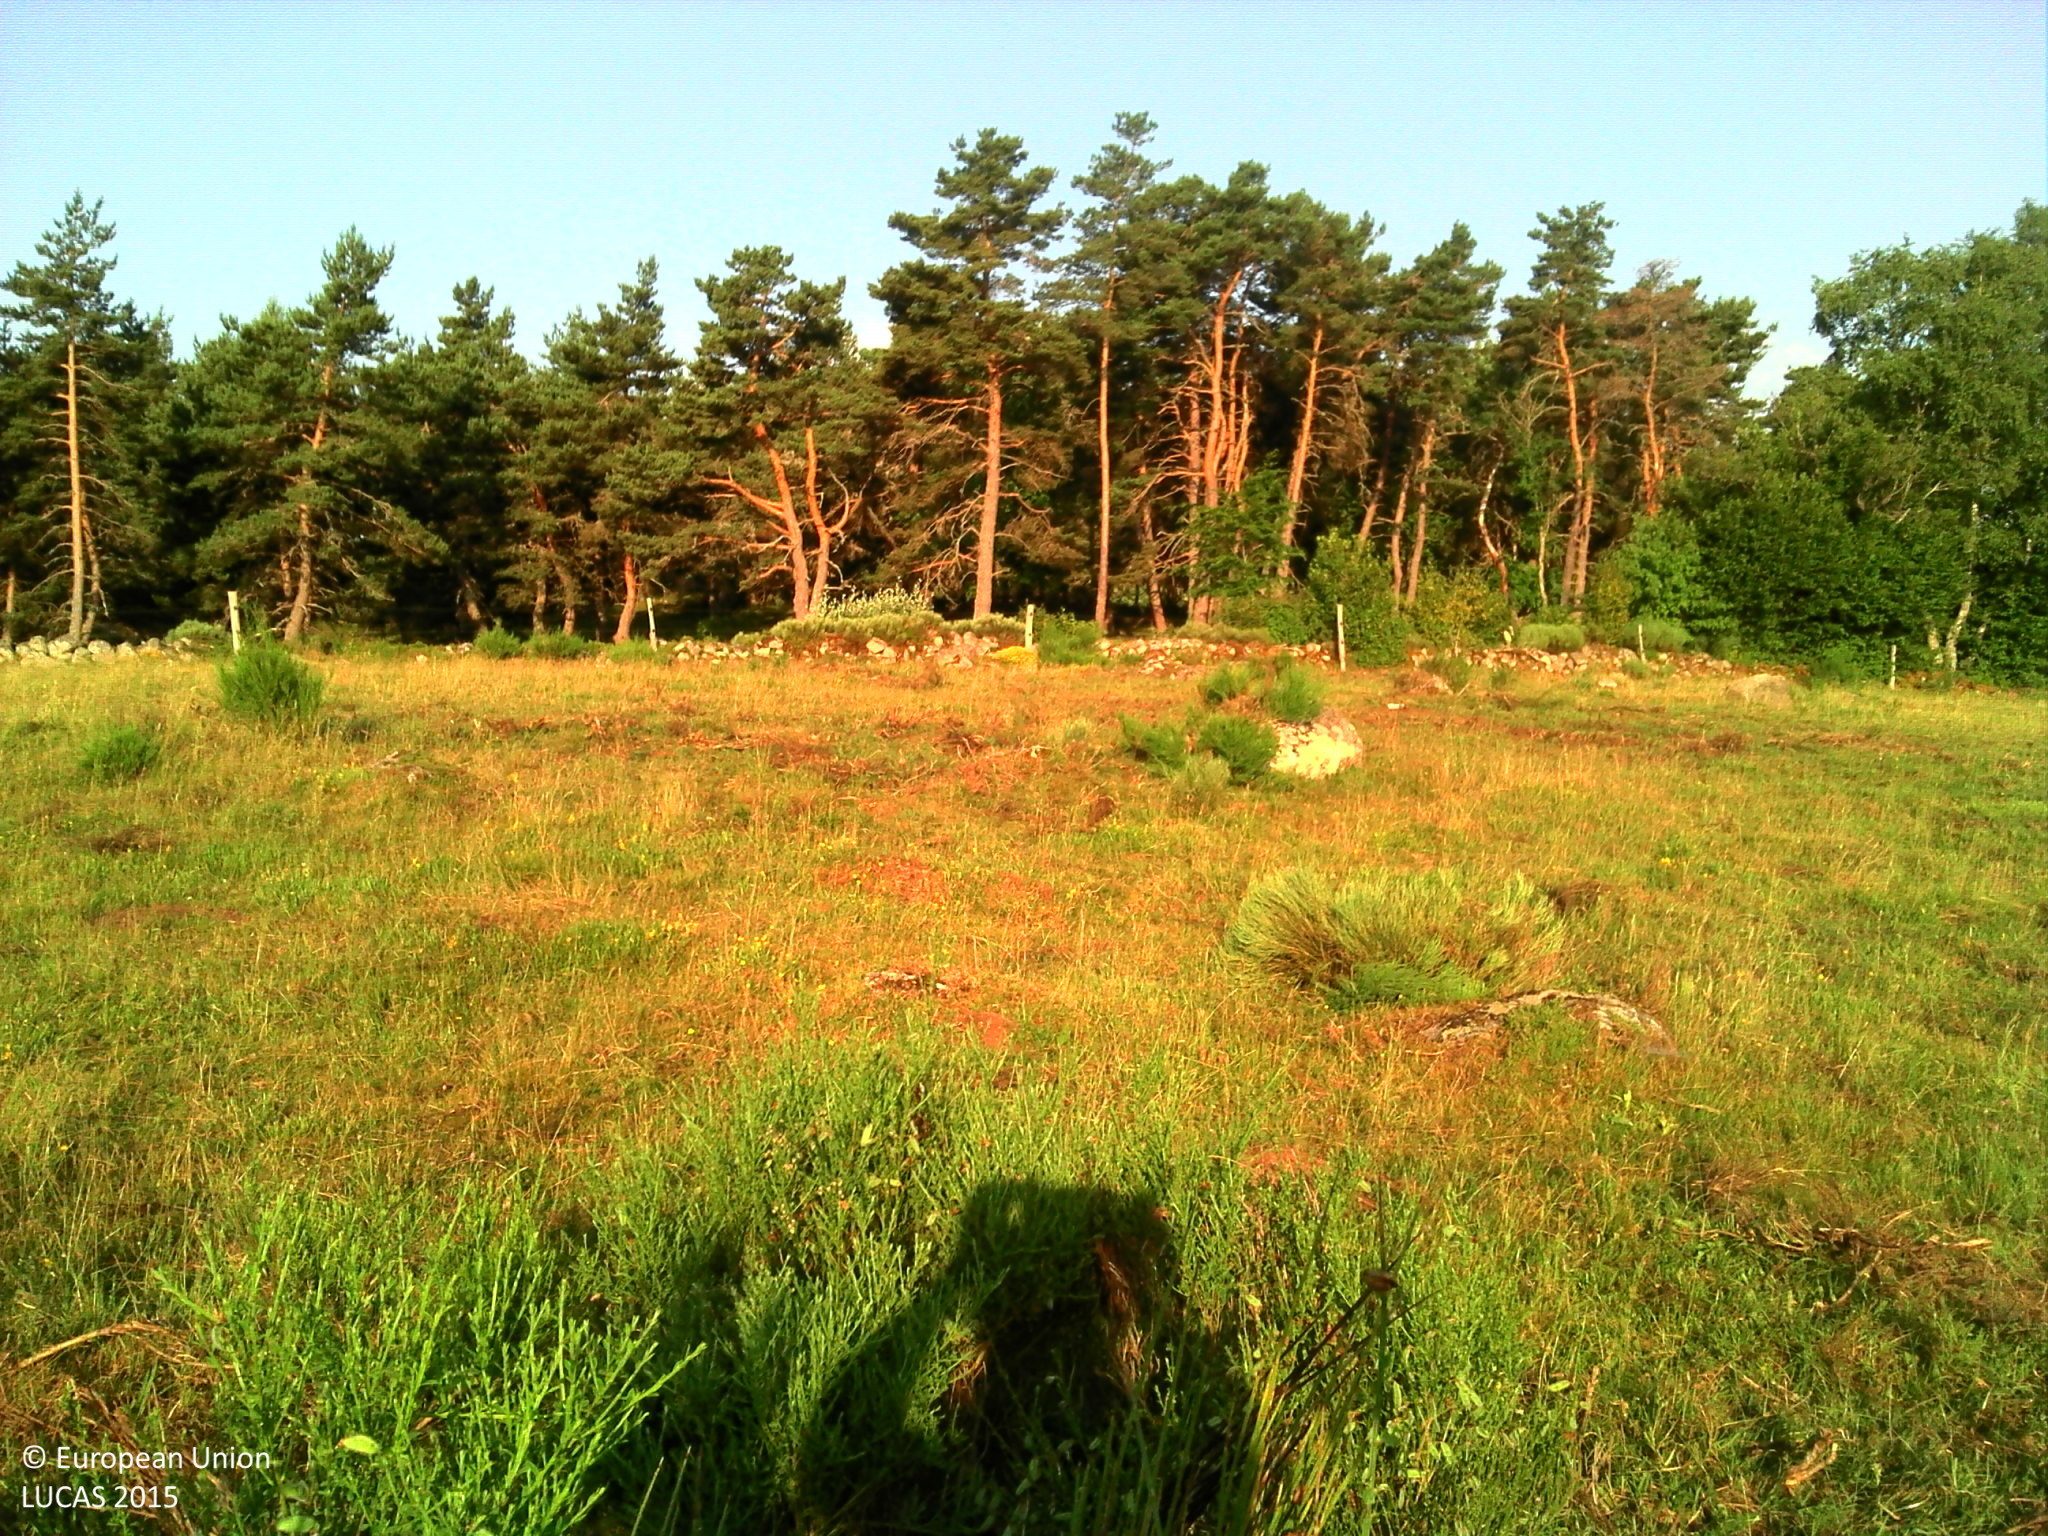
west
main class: Shrubland
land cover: Shrubland without tree cover
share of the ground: > 75 %
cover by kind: herbaceous plants 80 %, shrubs 20 %
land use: Agriculture (excluding fallow land and kitchen gardens)
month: July
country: FR
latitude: 44.7452
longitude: 2.9681
